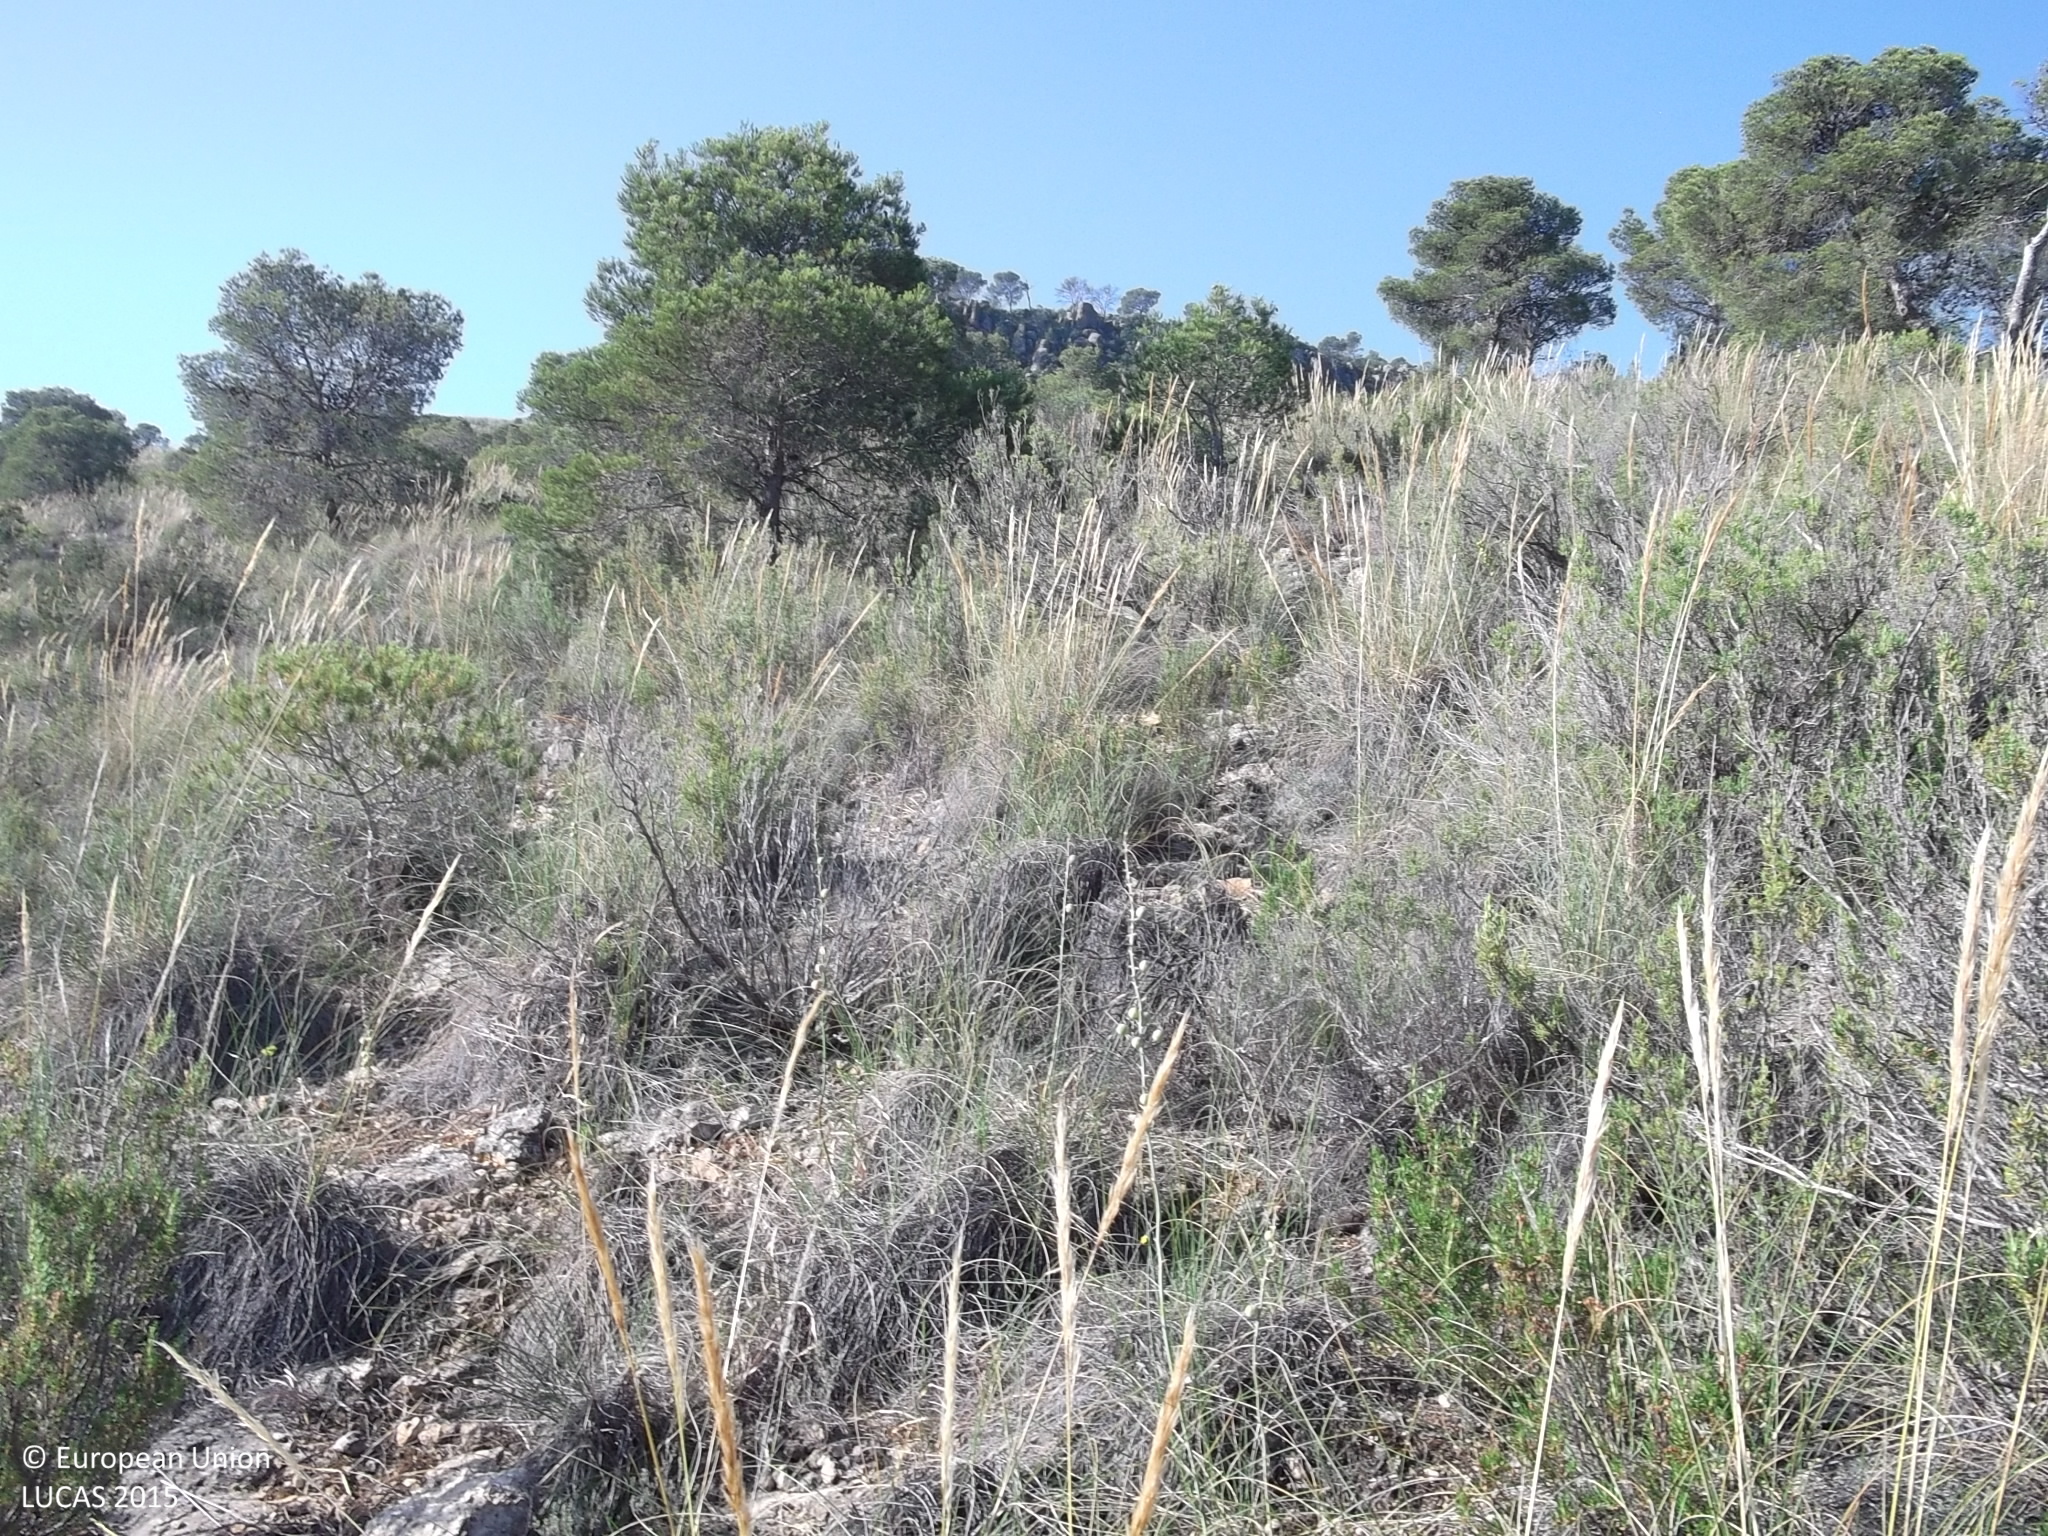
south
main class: Woodland
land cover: Pine dominated coniferous woodland
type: coniferous forest of the mediterranean region
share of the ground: 10 - 25 %
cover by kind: shrubs 40 %, coniferous forest trees 20 %, herbaceous plants 20 %, consolidated bare surface 20 %
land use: Semi-natural and natural areas not in use
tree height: > 5 m
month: May
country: ES
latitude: 38.4261
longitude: -1.5953
